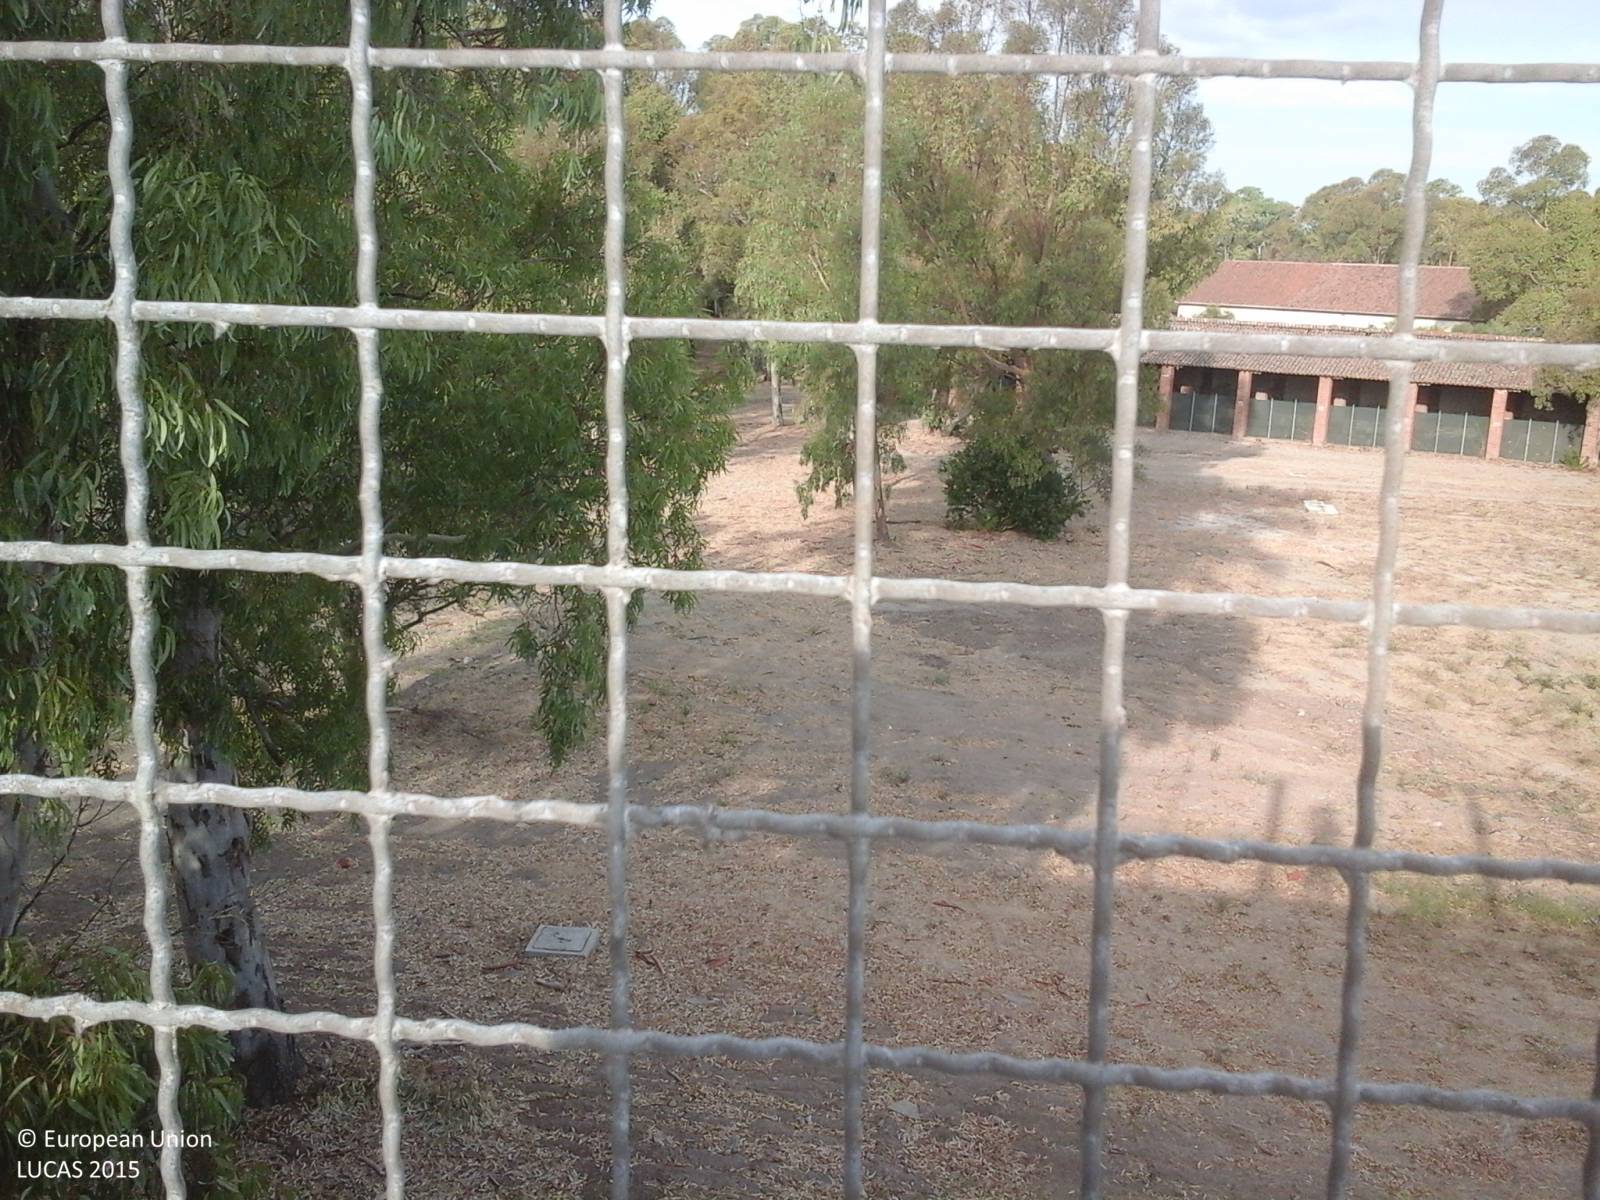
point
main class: Grassland
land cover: Grassland without tree/shrub cover
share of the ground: > 75 %
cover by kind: herbaceous plants 90 %, unconsolidated bare surface 10 %
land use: Community services
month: August
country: IT
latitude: 40.9175
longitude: 9.4918
